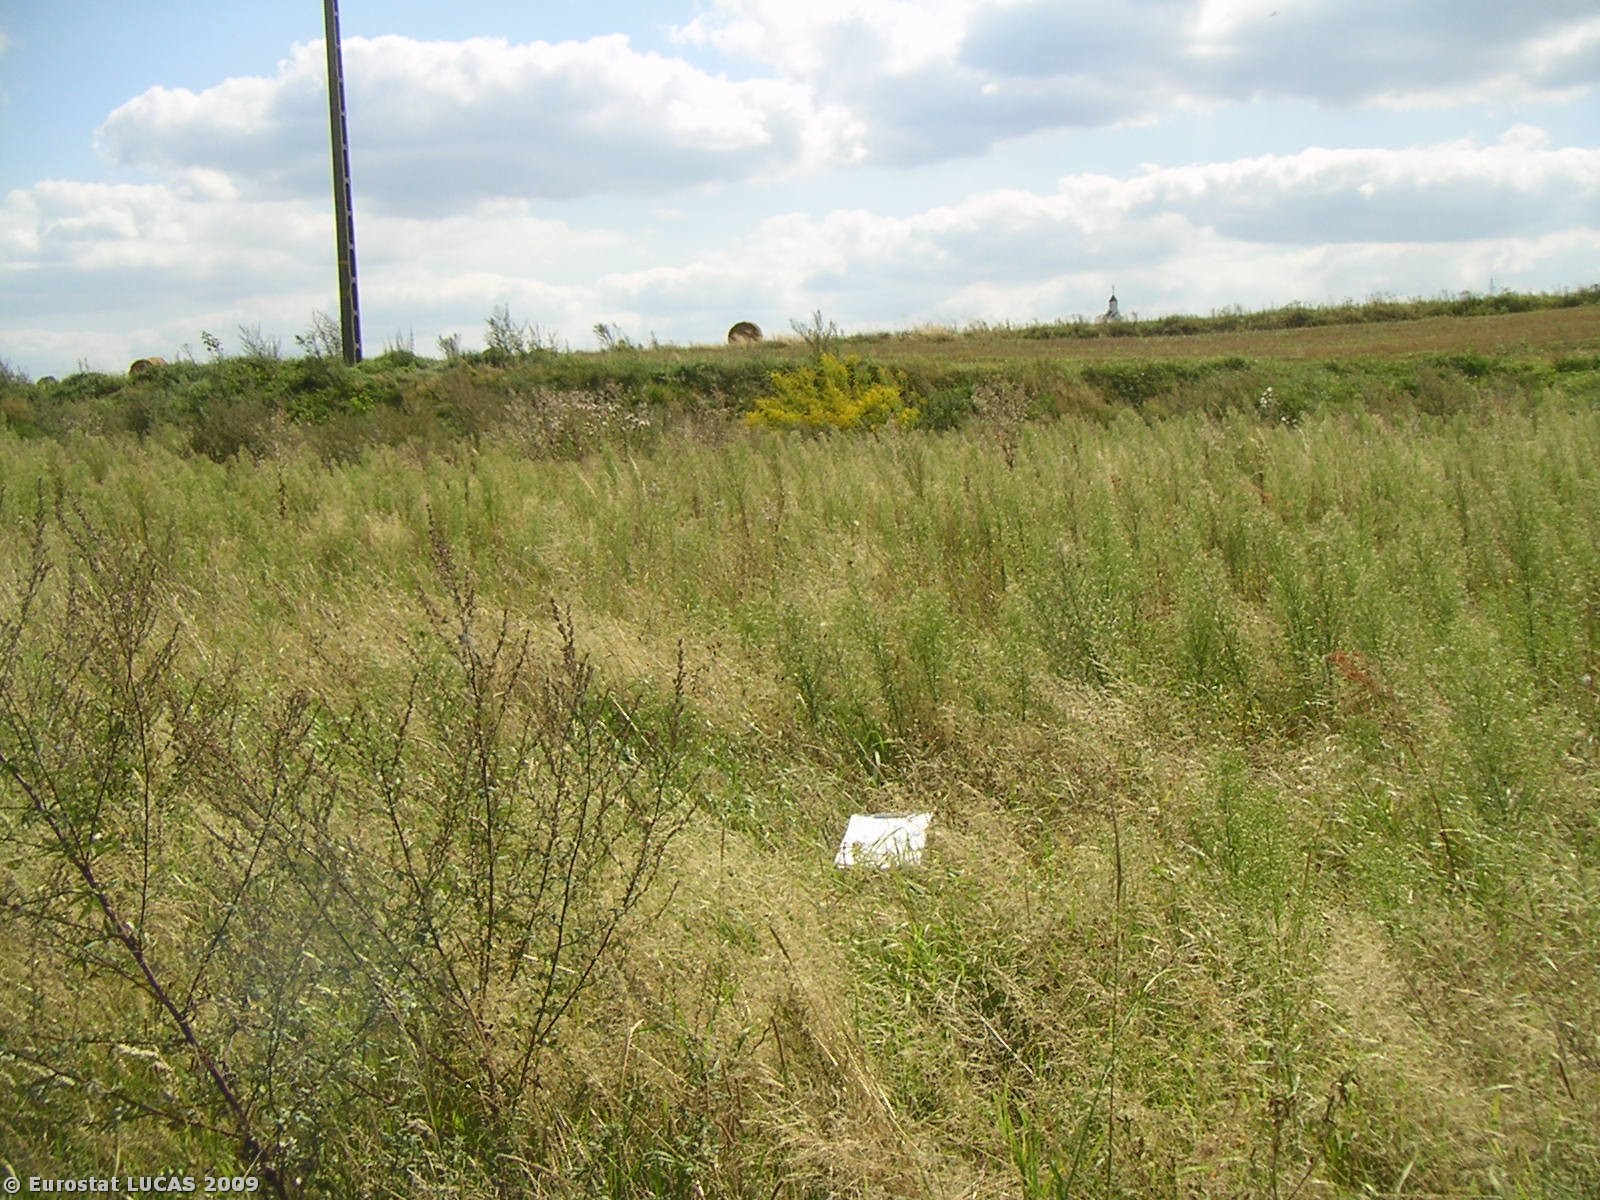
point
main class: Grassland
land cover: Spontaneously vegetated surfaces
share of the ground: > 75 %
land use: Fallow land
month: August
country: PL
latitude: 50.4566
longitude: 18.8251
